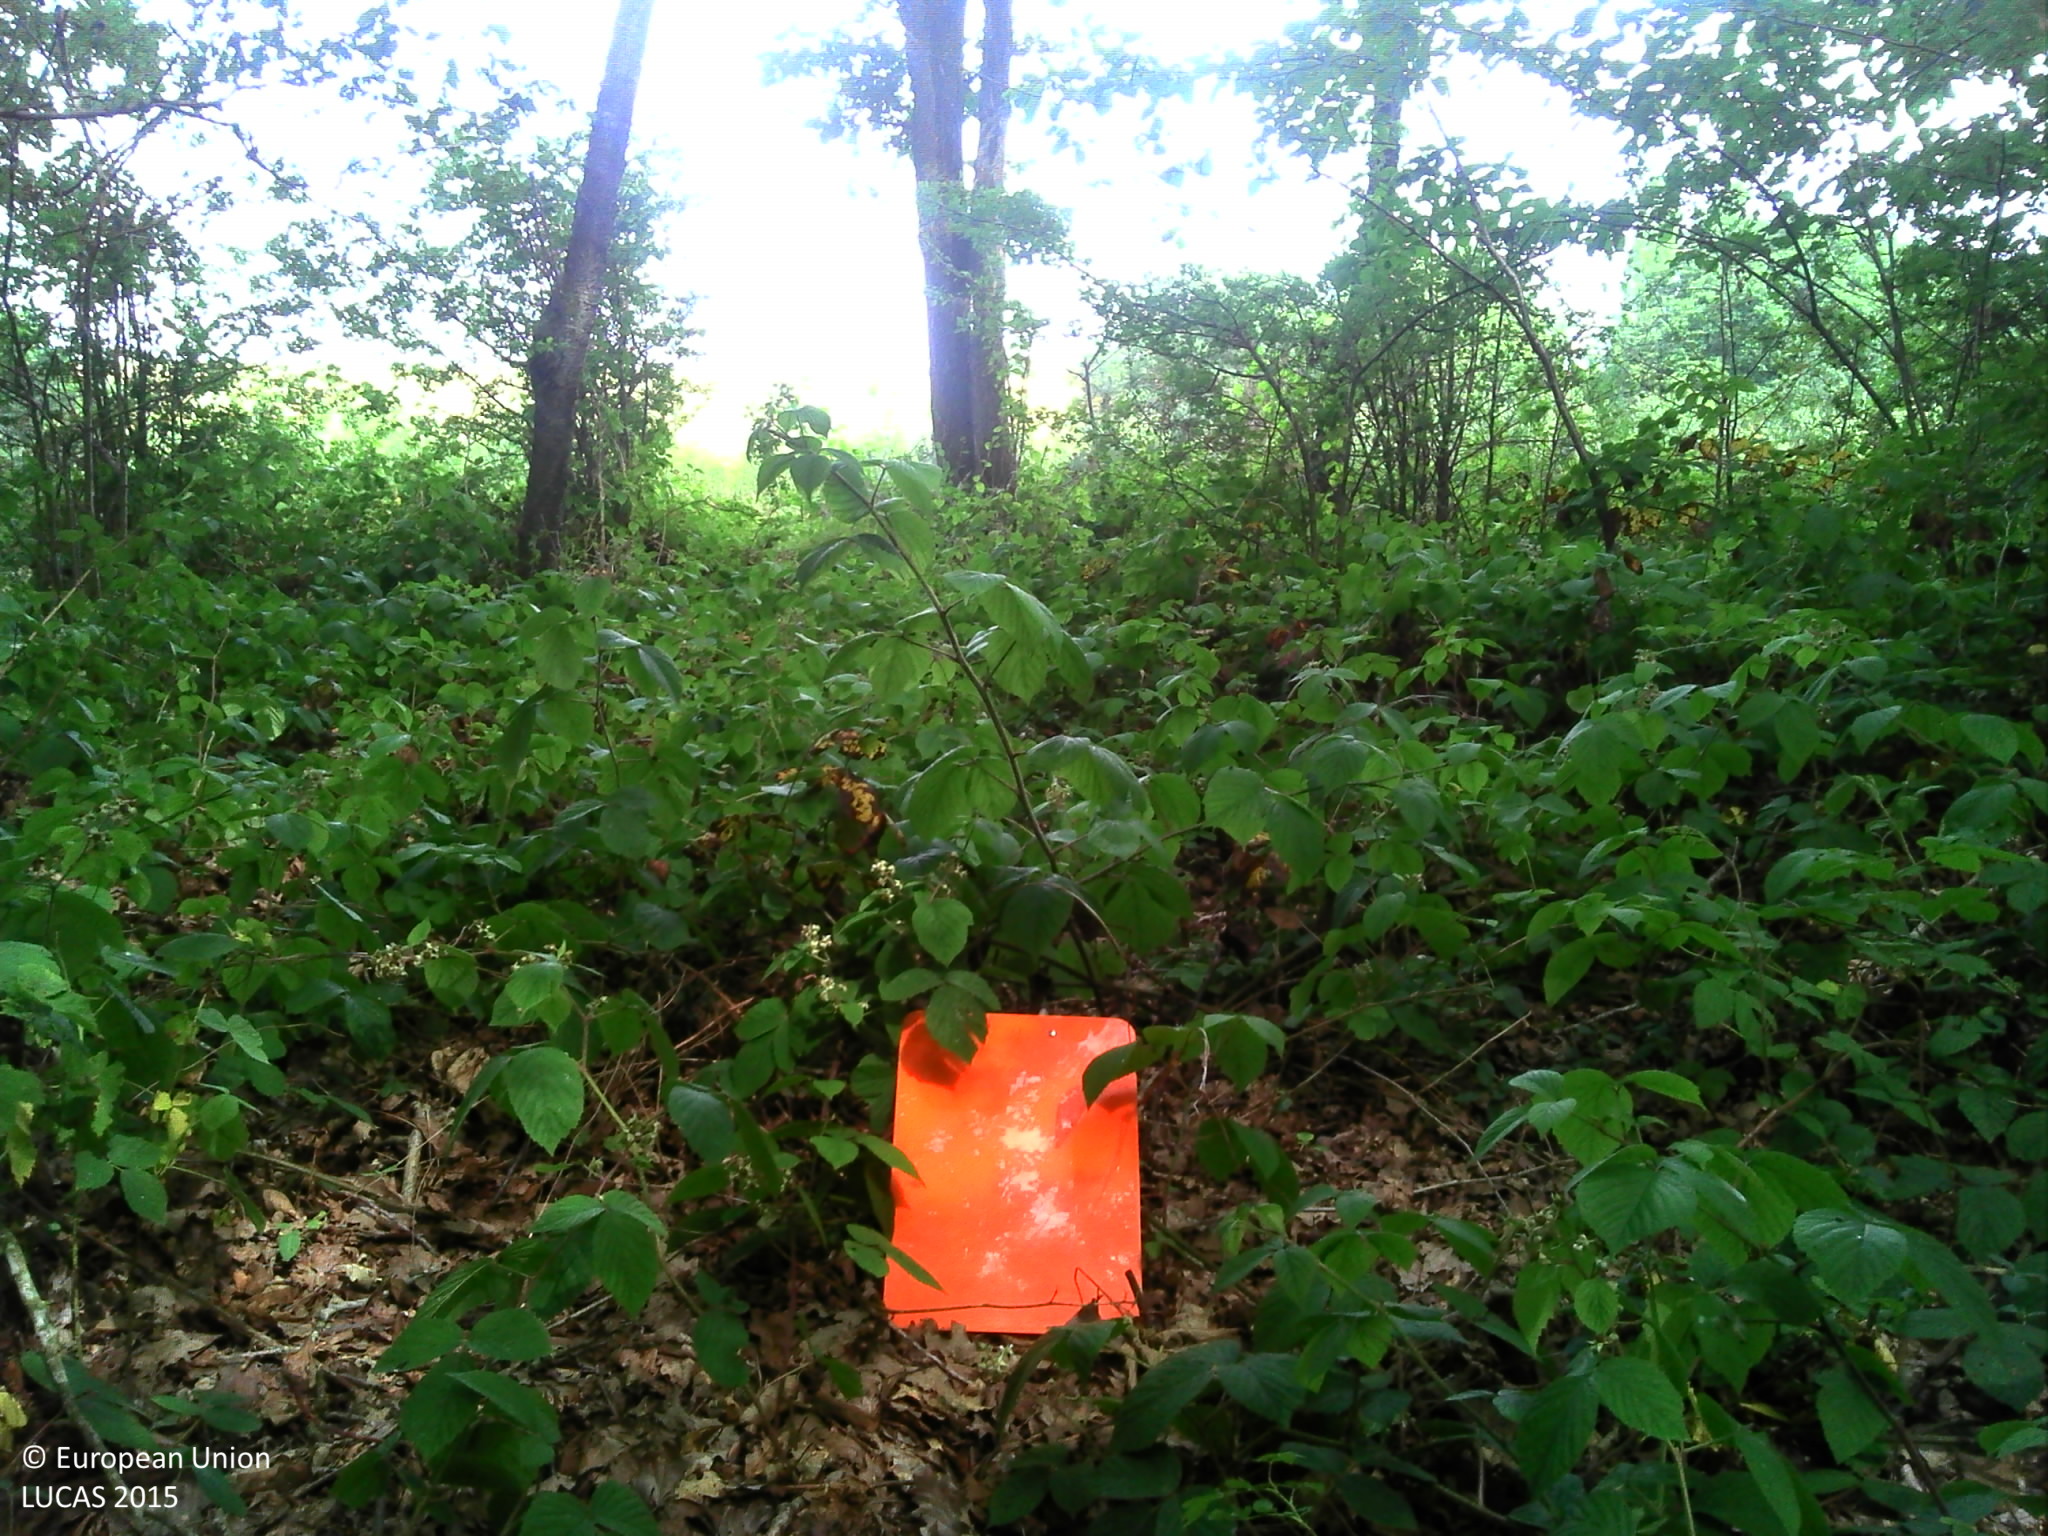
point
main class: Woodland
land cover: Broadleaved woodland
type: acidophilous oak and oak-birch forest
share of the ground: > 75 %
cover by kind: broadleaved forest trees 80 %, herbaceous plants 10 %, lichens and mosses 10 %
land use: Forestry
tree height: > 5 m
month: June
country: FR
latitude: 48.6105
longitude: 1.3967
